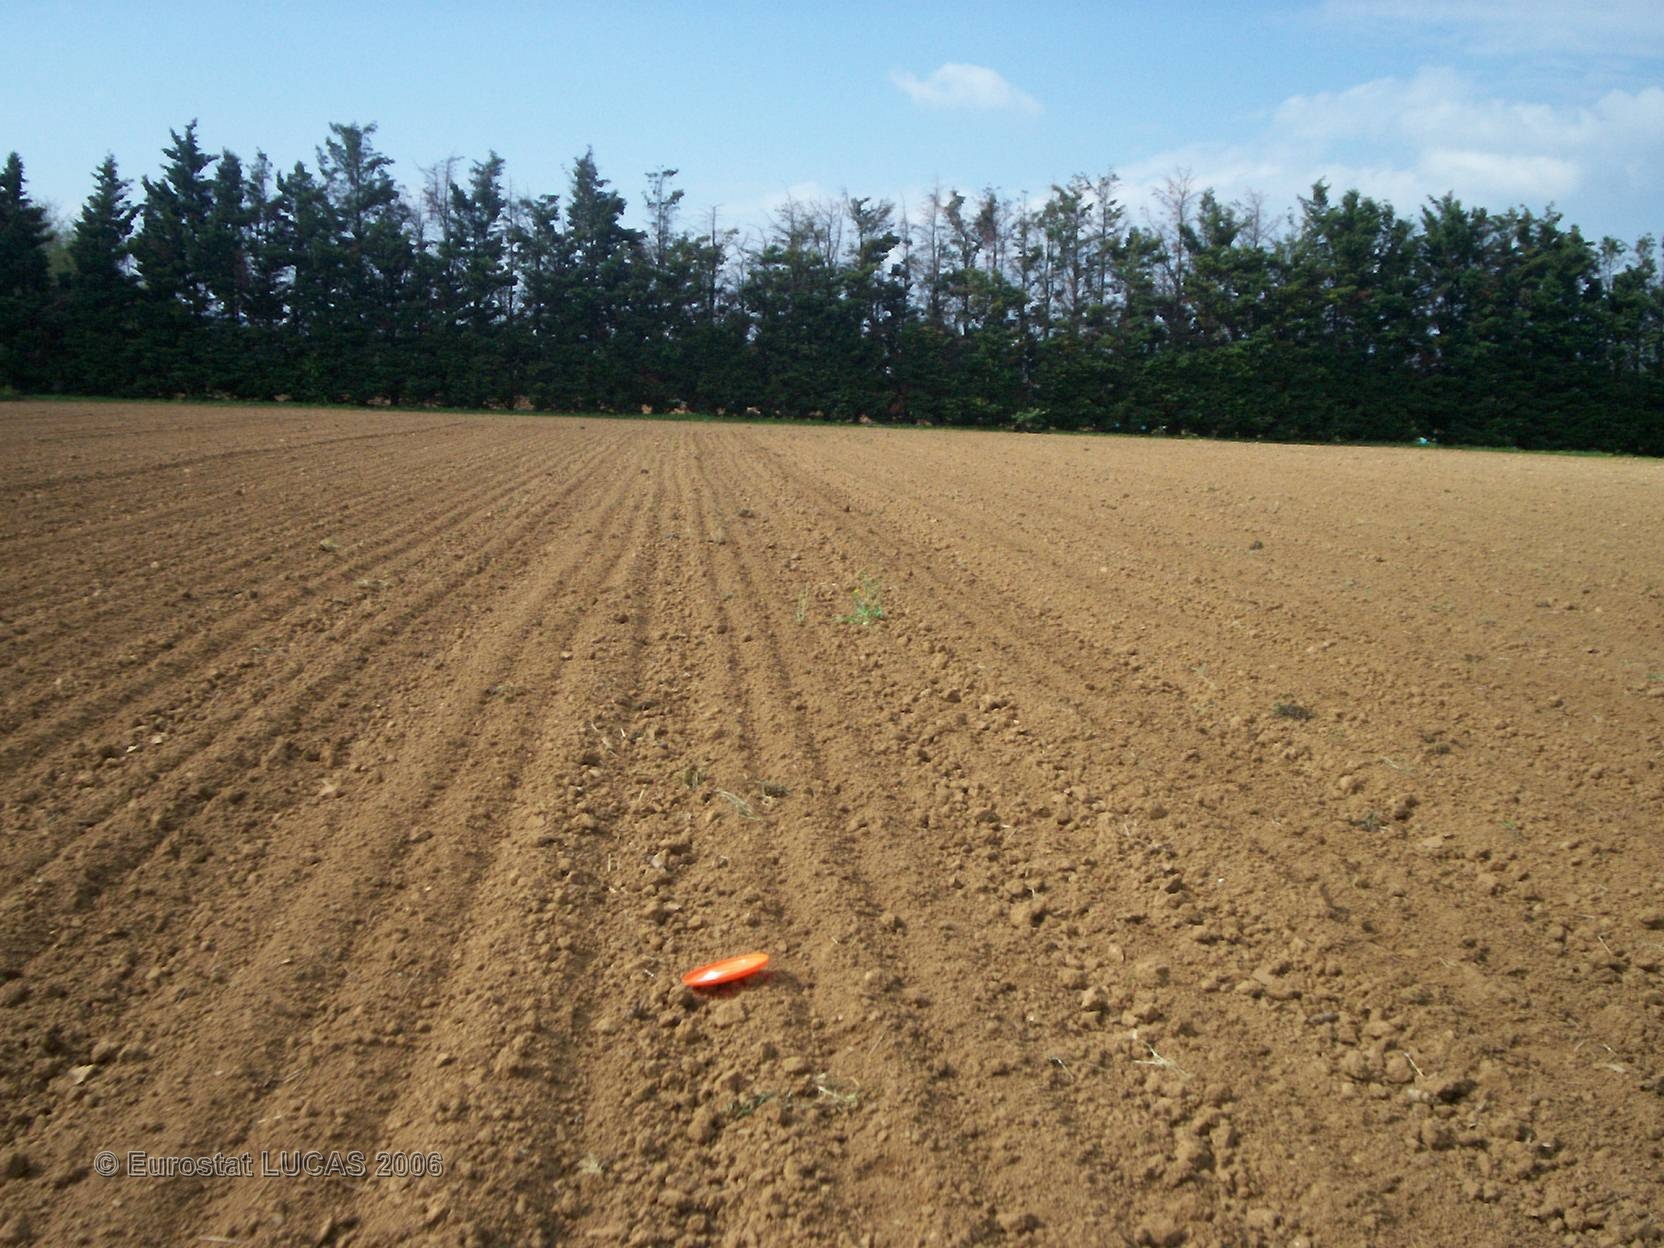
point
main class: Cropland
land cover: Maize
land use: Agriculture (excluding fallow land and kitchen gardens)
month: June
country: FR
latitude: 44.8026
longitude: 4.8859
